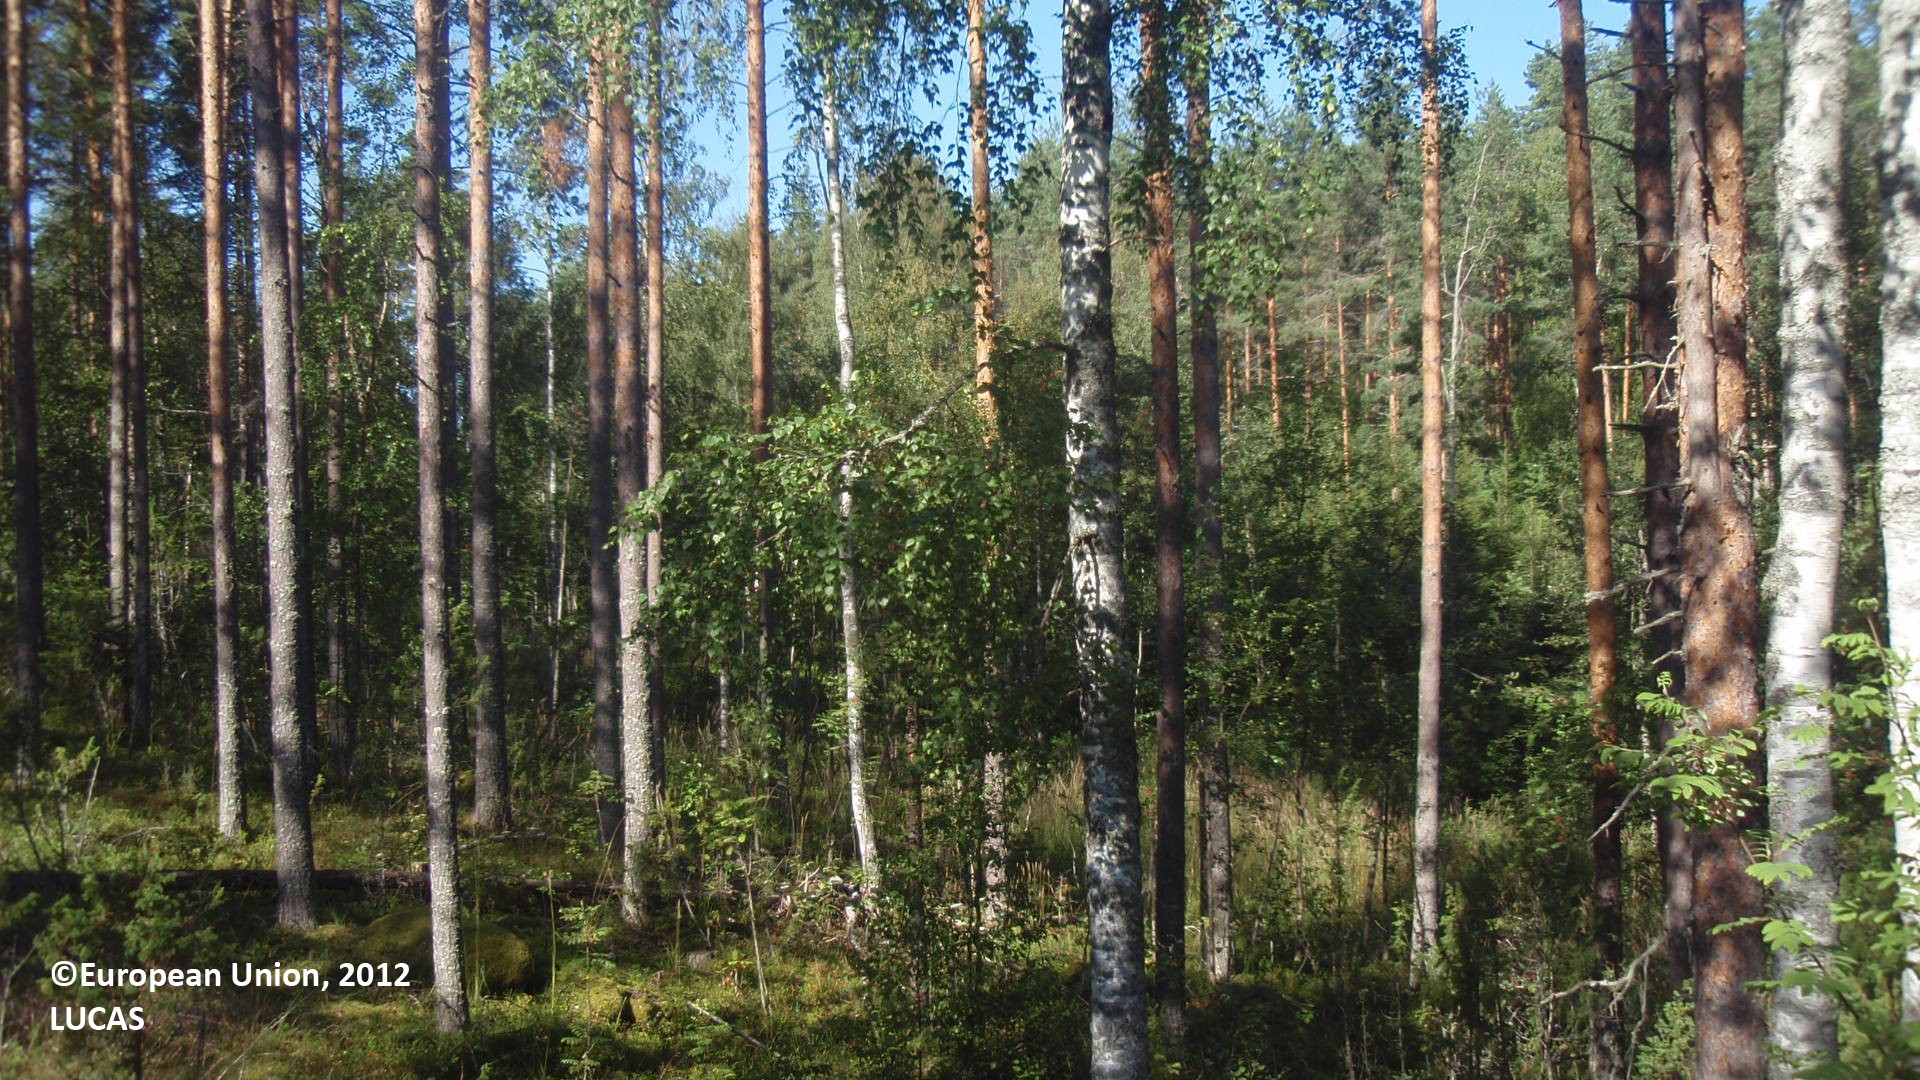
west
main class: Woodland
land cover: Pine dominated coniferous woodland
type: boreal forest
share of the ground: 50 - 75 %
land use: Forestry
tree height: > 5 m
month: August
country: FI
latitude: 61.4358
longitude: 27.8699
